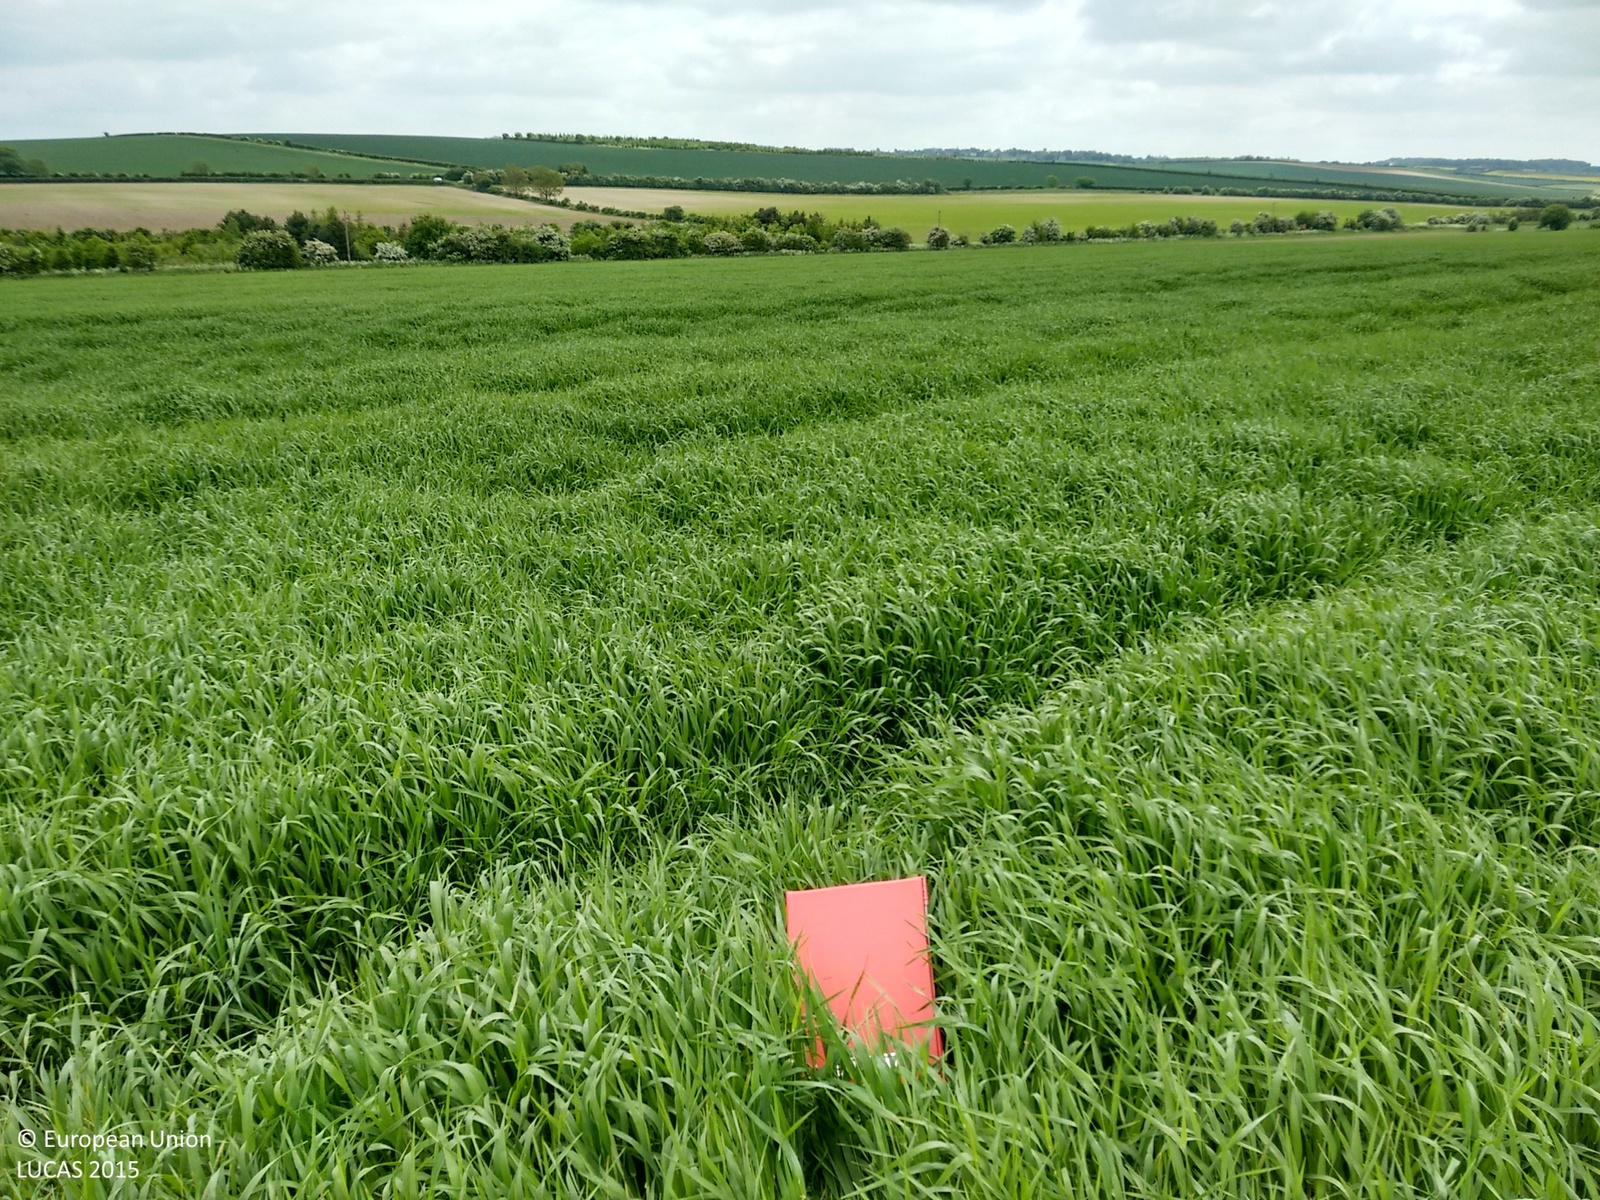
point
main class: Cropland
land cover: Barley
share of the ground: > 75 %
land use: Agriculture (excluding fallow land and kitchen gardens)
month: May
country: GB
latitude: 52.0480
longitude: 0.0377
